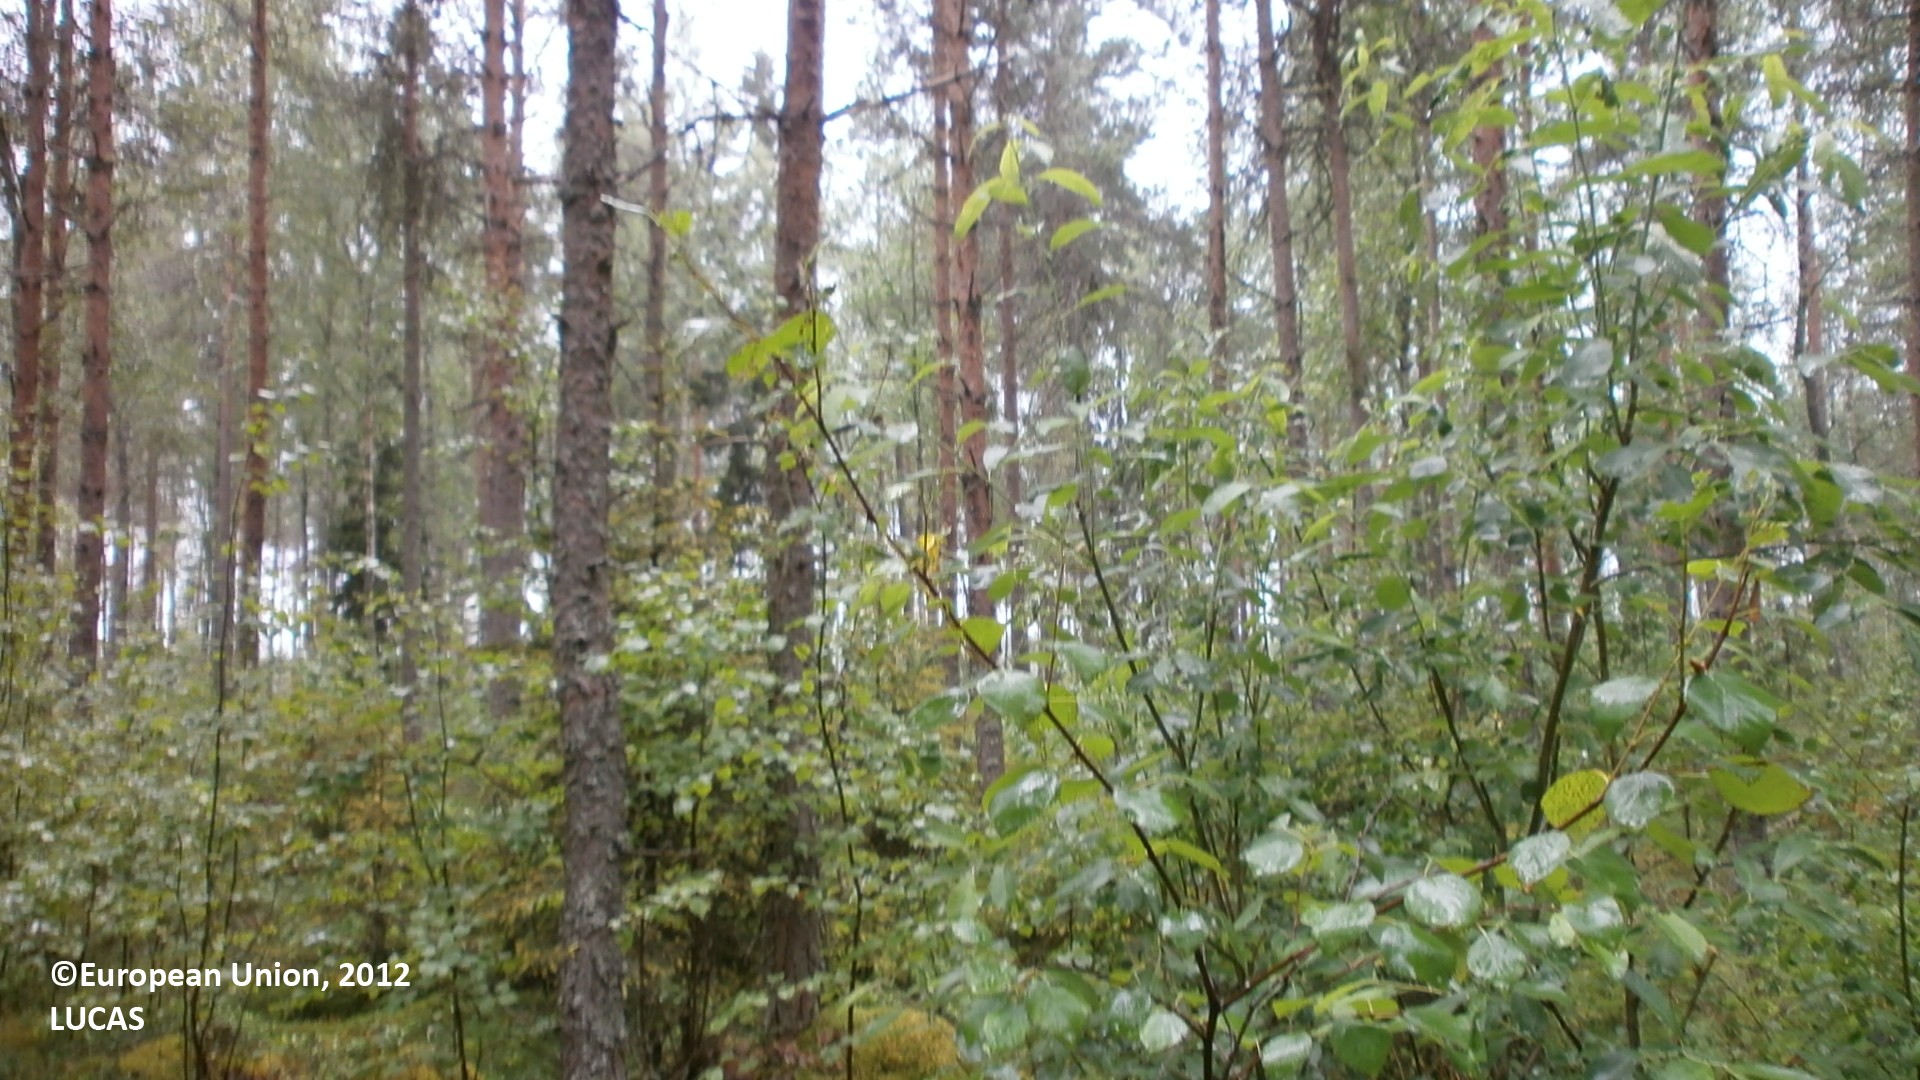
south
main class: Woodland
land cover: Pine dominated coniferous woodland
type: boreal forest
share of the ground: 50 - 75 %
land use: Forestry
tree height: > 5 m
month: July
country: FI
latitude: 64.0663
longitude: 23.8132
